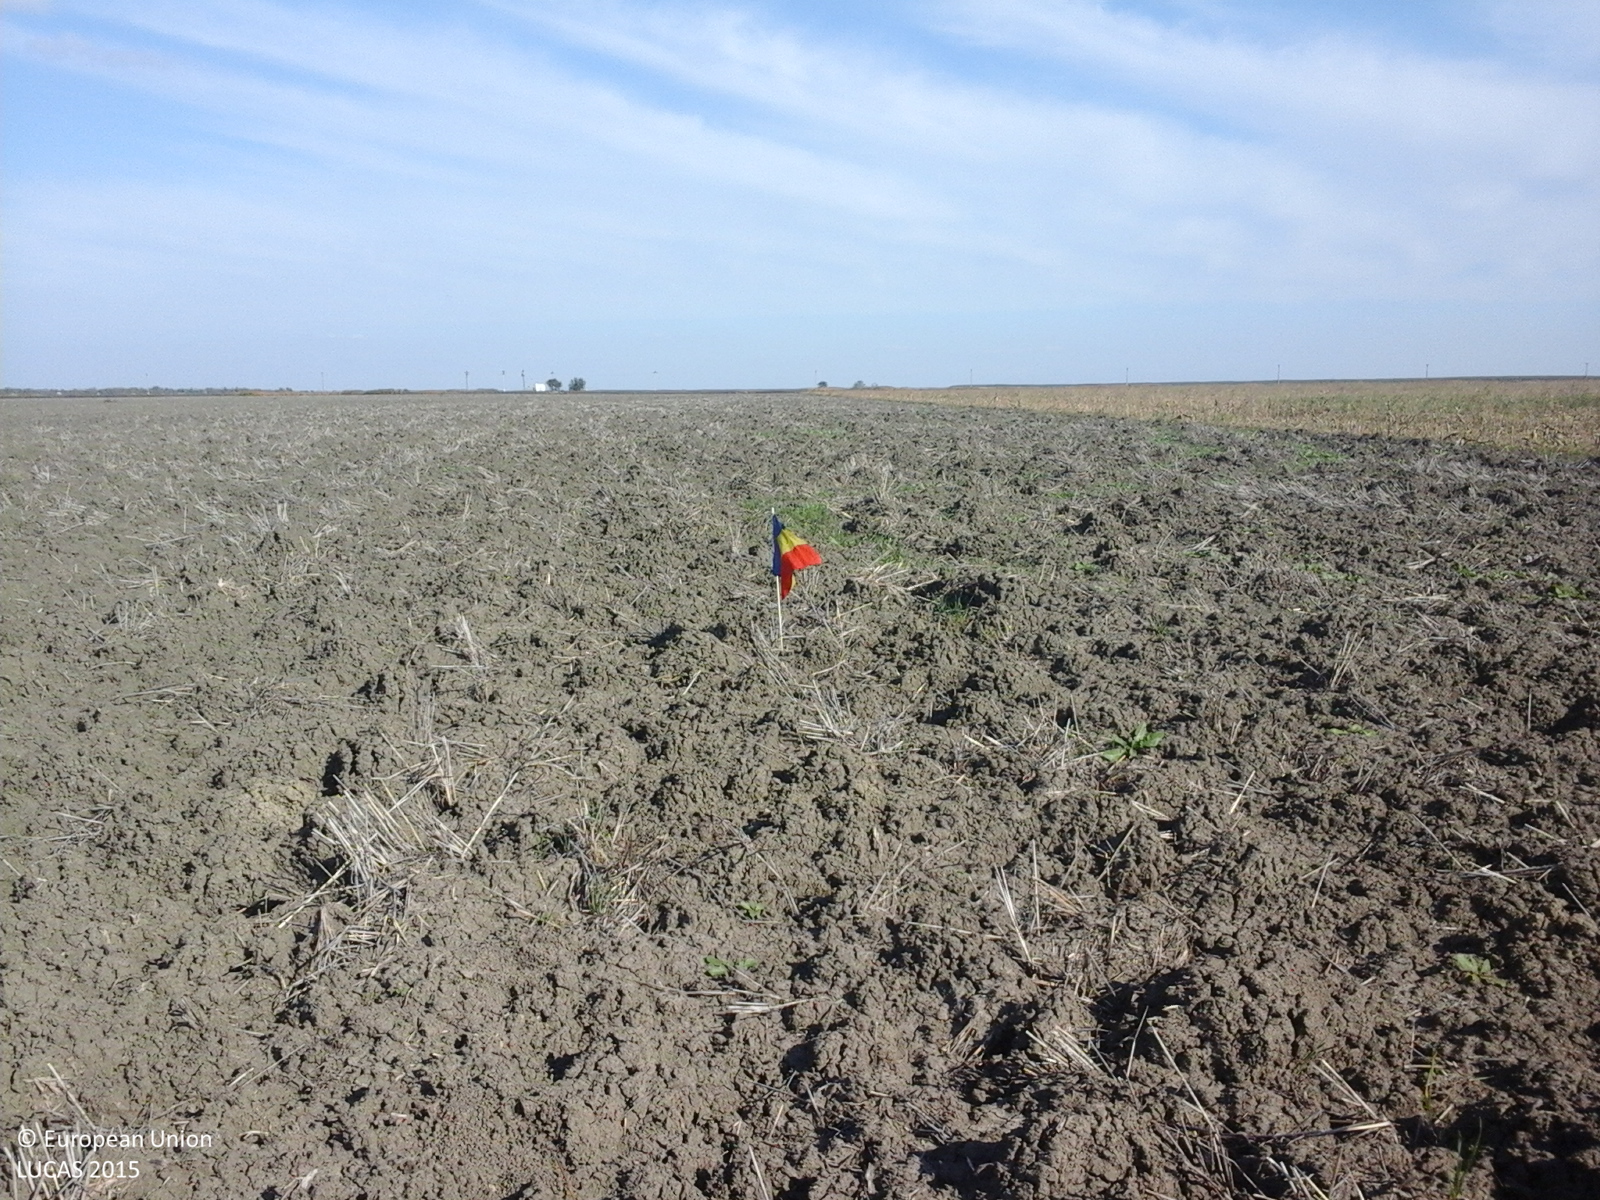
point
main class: Cropland
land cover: Durum wheat
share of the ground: > 75 %
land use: Agriculture (excluding fallow land and kitchen gardens)
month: October
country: RO
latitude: 45.4410
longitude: 27.4222
